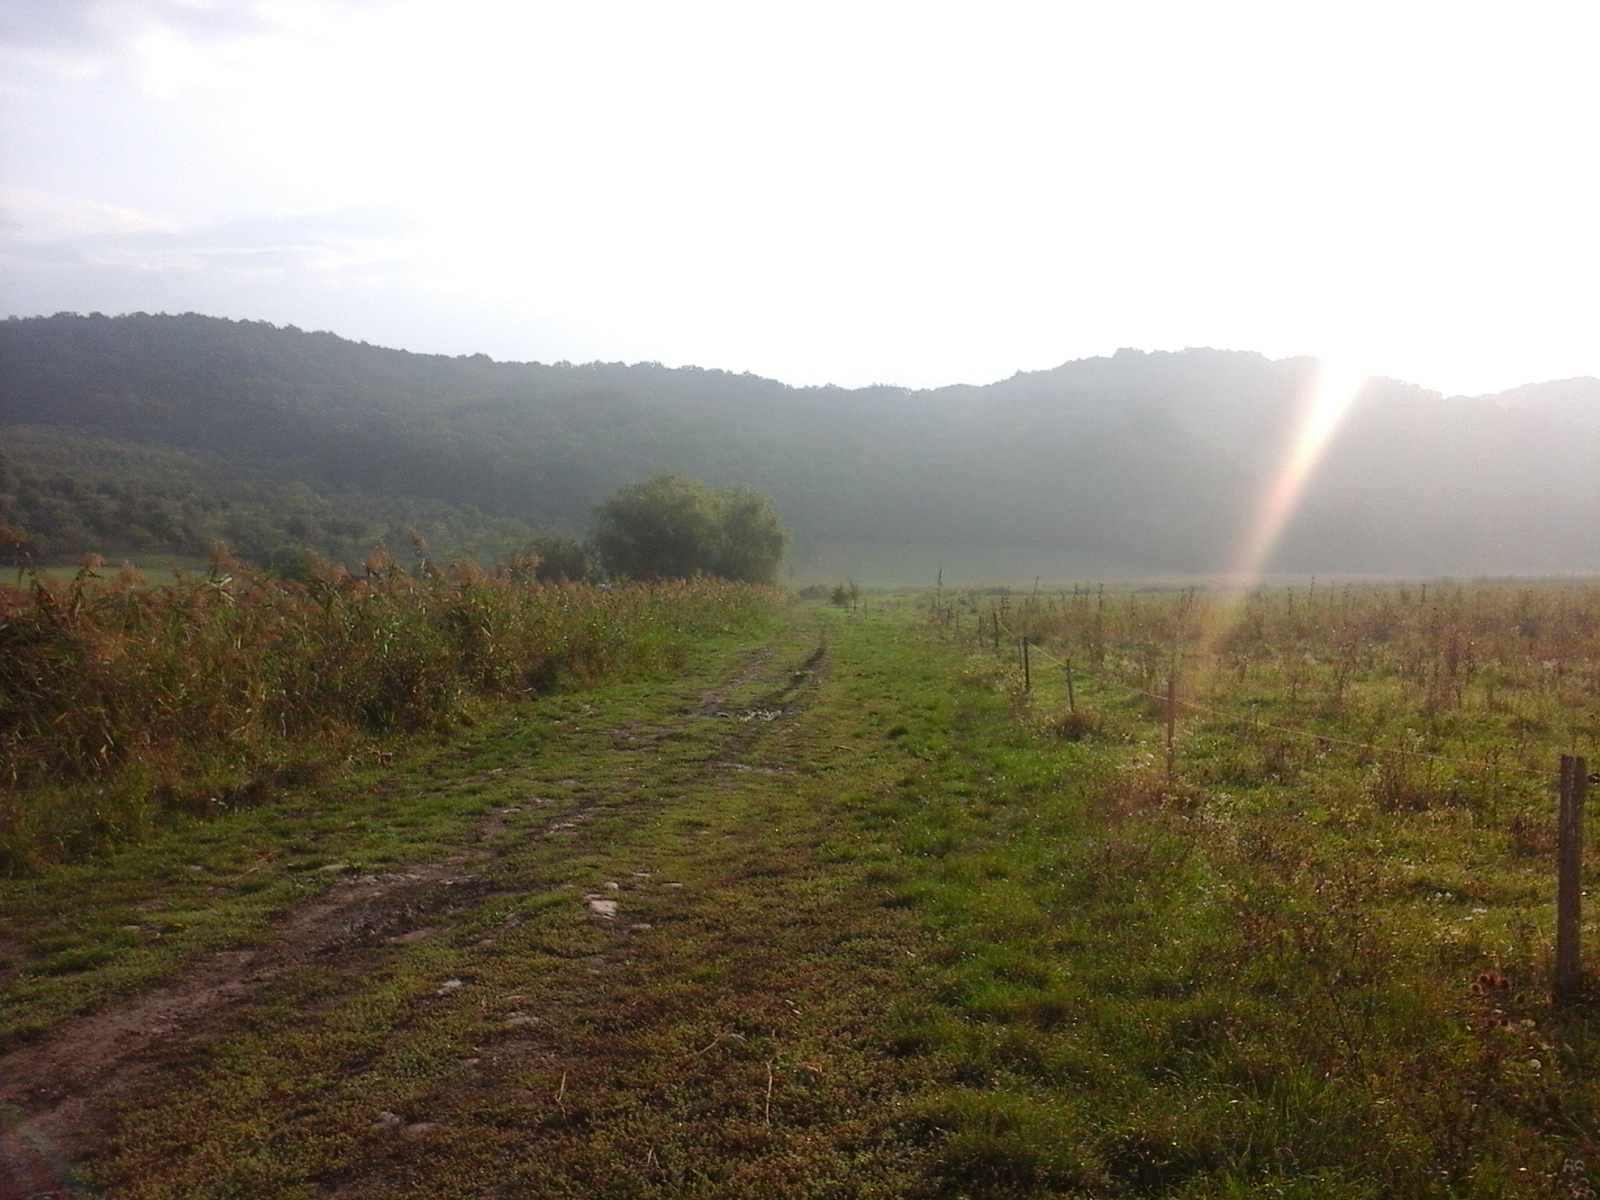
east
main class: Grassland
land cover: Spontaneously vegetated surfaces
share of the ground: > 75 %
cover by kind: herbaceous plants 100 %
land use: Agriculture (excluding fallow land and kitchen gardens)
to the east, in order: Spontaneously vegetated surfaces; Fences; Spontaneously vegetated surfaces; Grassland without tree/shrub cover; Spontaneously vegetated surfaces; Grassland without tree/shrub cover
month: September
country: RO
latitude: 45.6128
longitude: 22.9661
